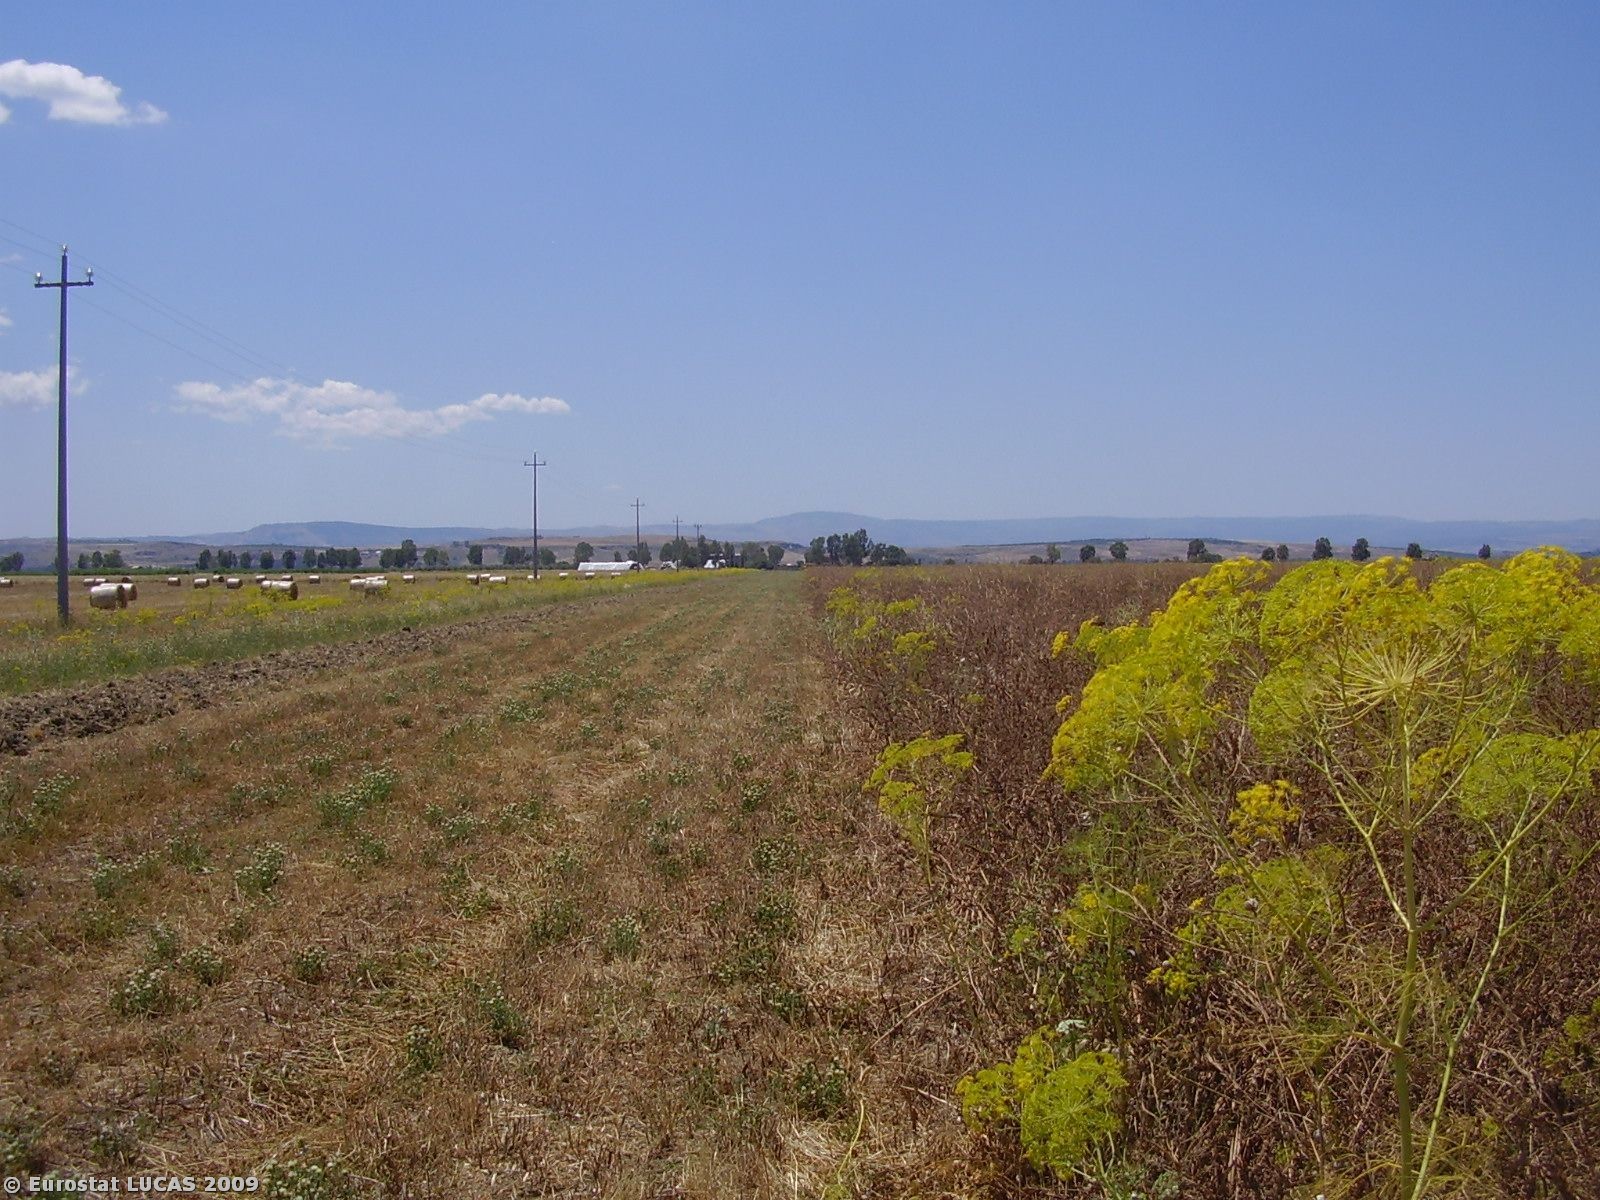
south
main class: Cropland
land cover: Other cereals
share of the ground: > 75 %
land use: Agriculture (excluding fallow land and kitchen gardens)
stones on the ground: < 10 %
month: June
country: IT
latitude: 37.3994
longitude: 14.9679
